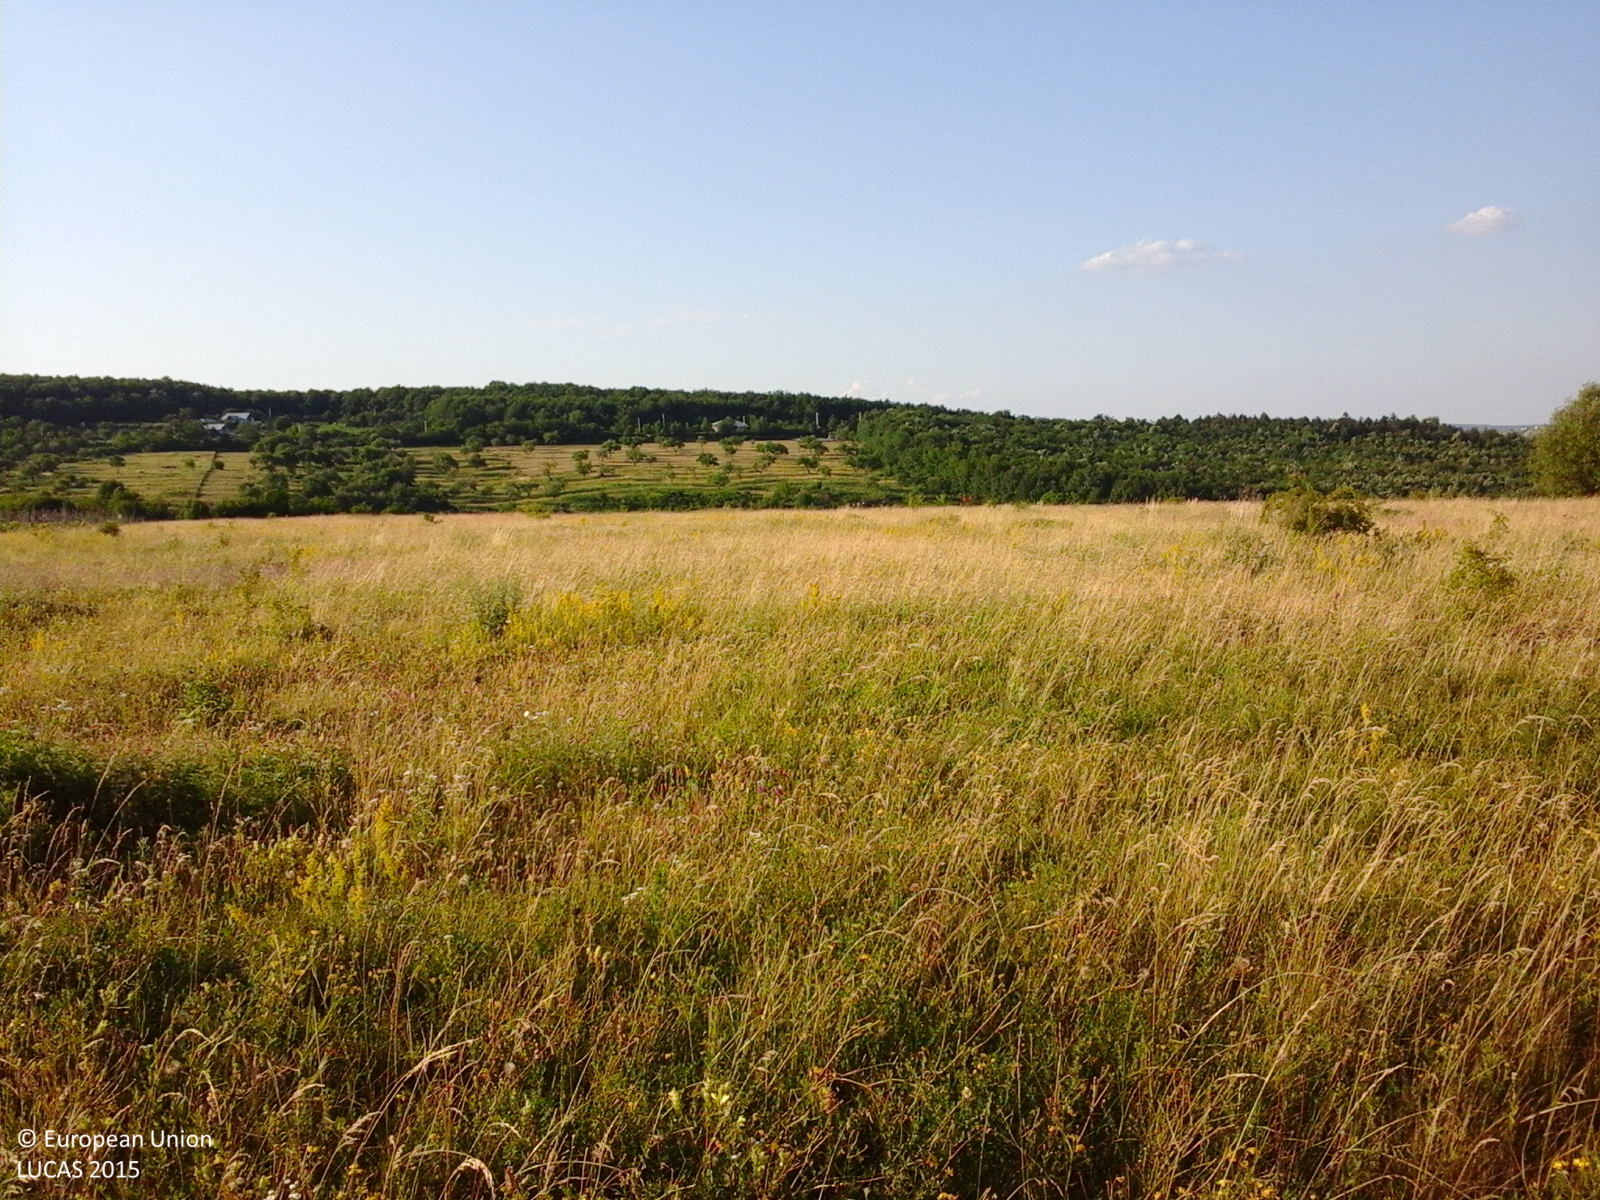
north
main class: Grassland
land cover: Grassland without tree/shrub cover
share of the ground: > 75 %
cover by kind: herbaceous plants 100 %
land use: Agriculture (excluding fallow land and kitchen gardens)
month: June
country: RO
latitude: 47.5951
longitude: 26.8429
